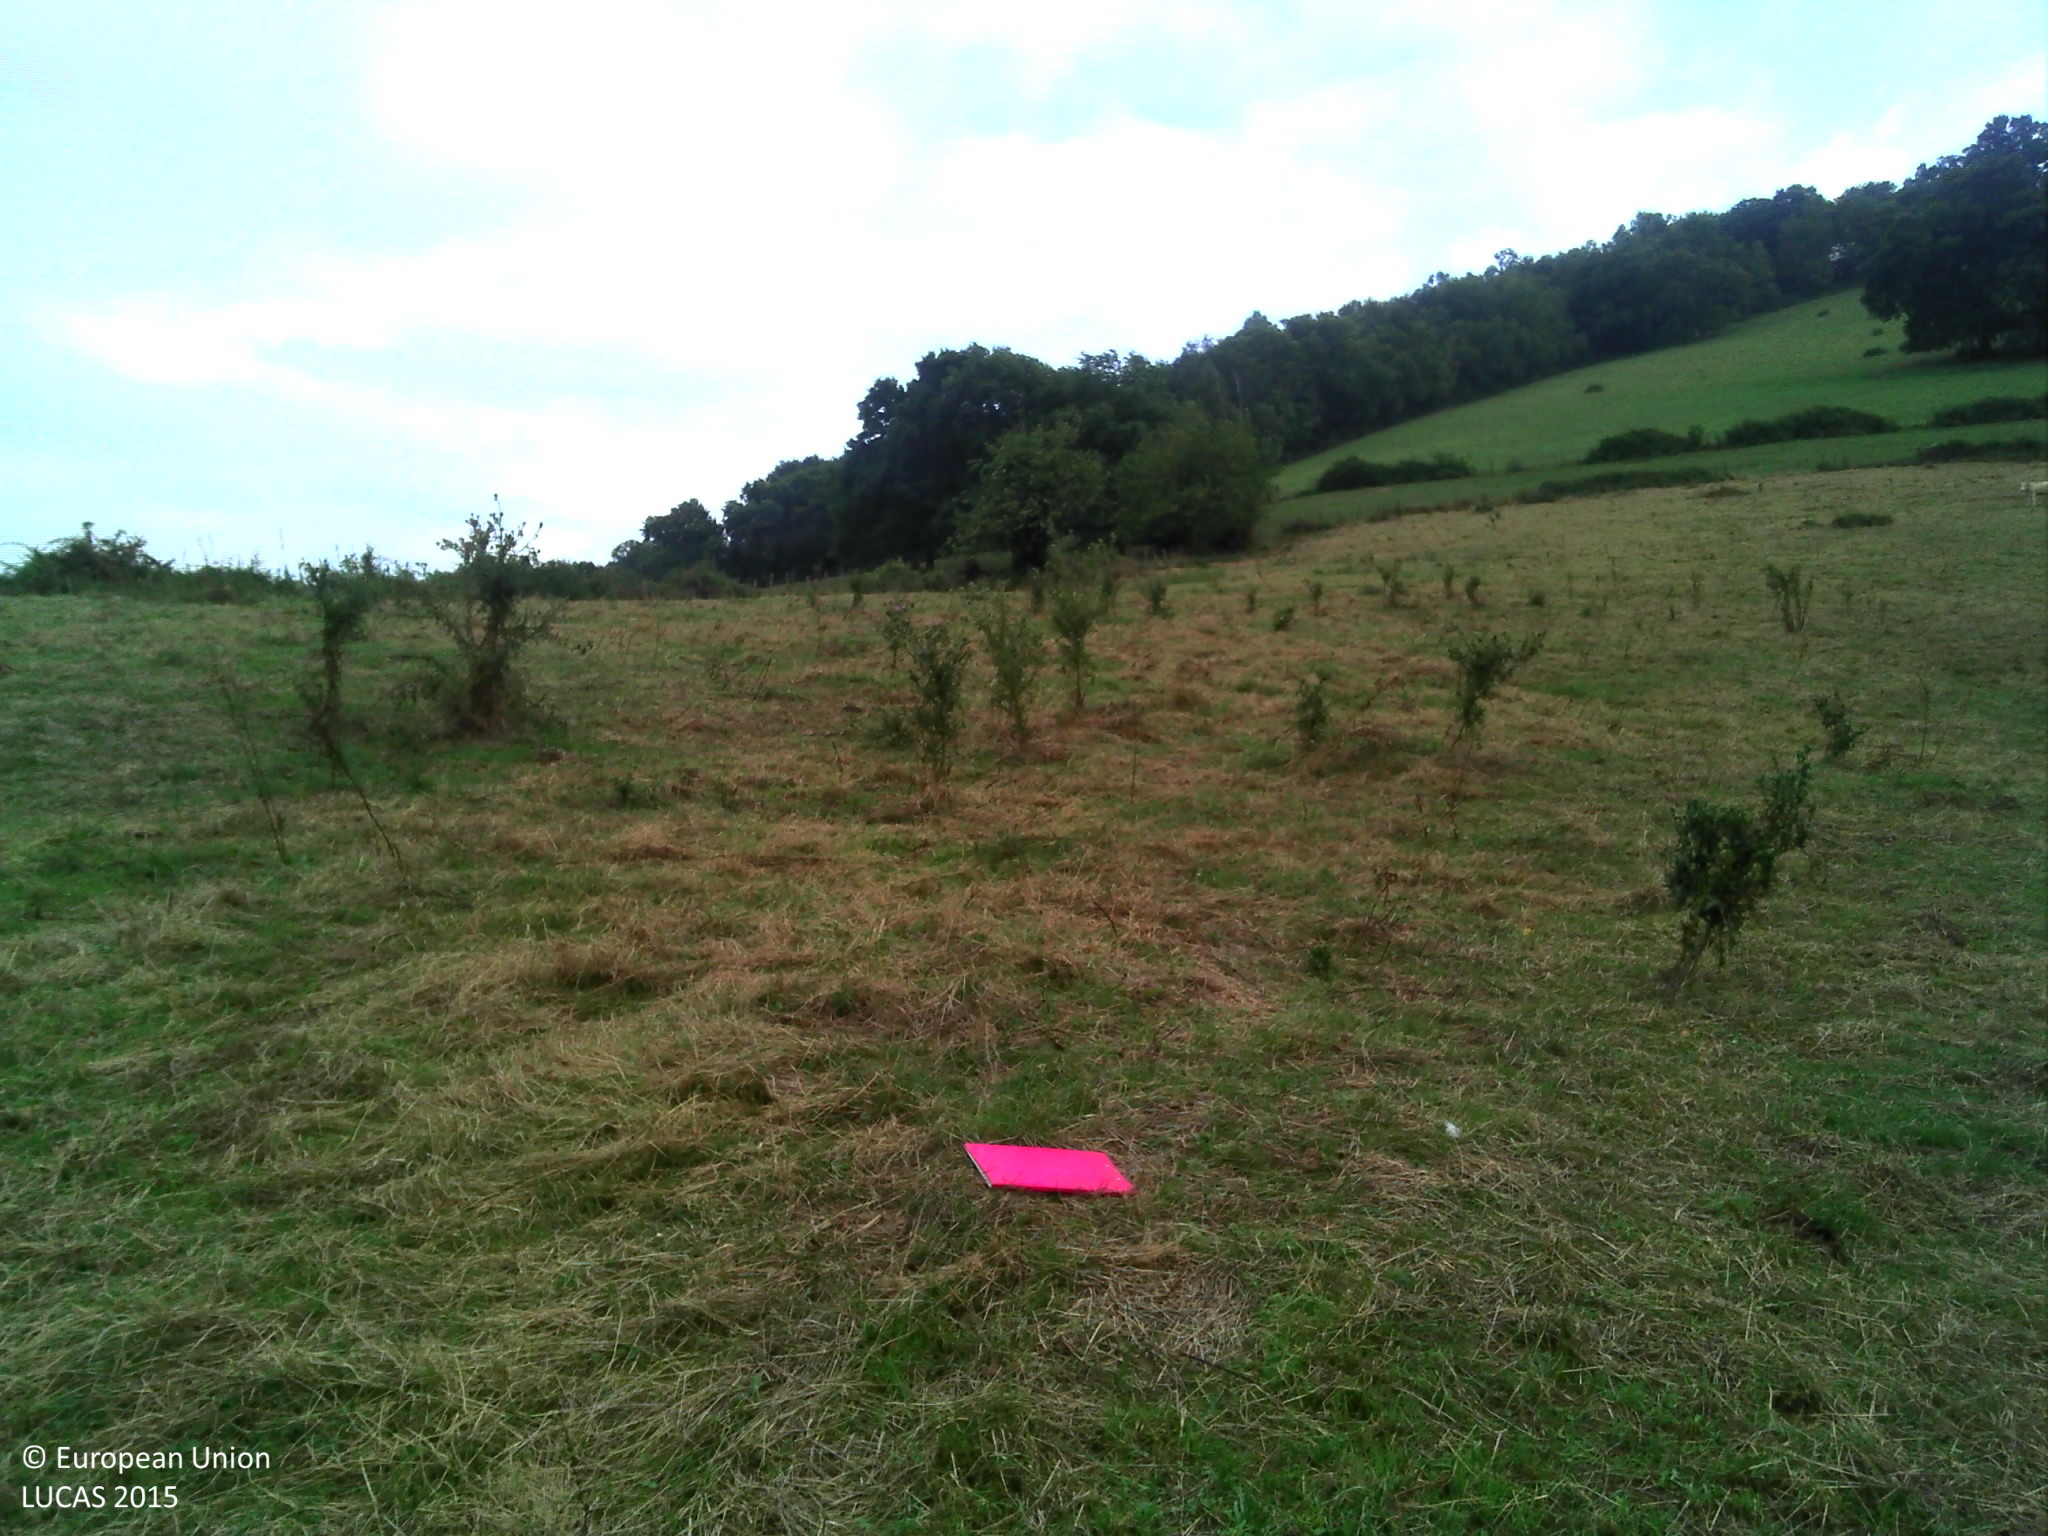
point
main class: Grassland
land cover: Grassland without tree/shrub cover
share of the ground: > 75 %
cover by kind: herbaceous plants 95 %, shrubs 5 %
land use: Agriculture (excluding fallow land and kitchen gardens)
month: August
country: FR
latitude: 43.3523
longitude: -1.1049
